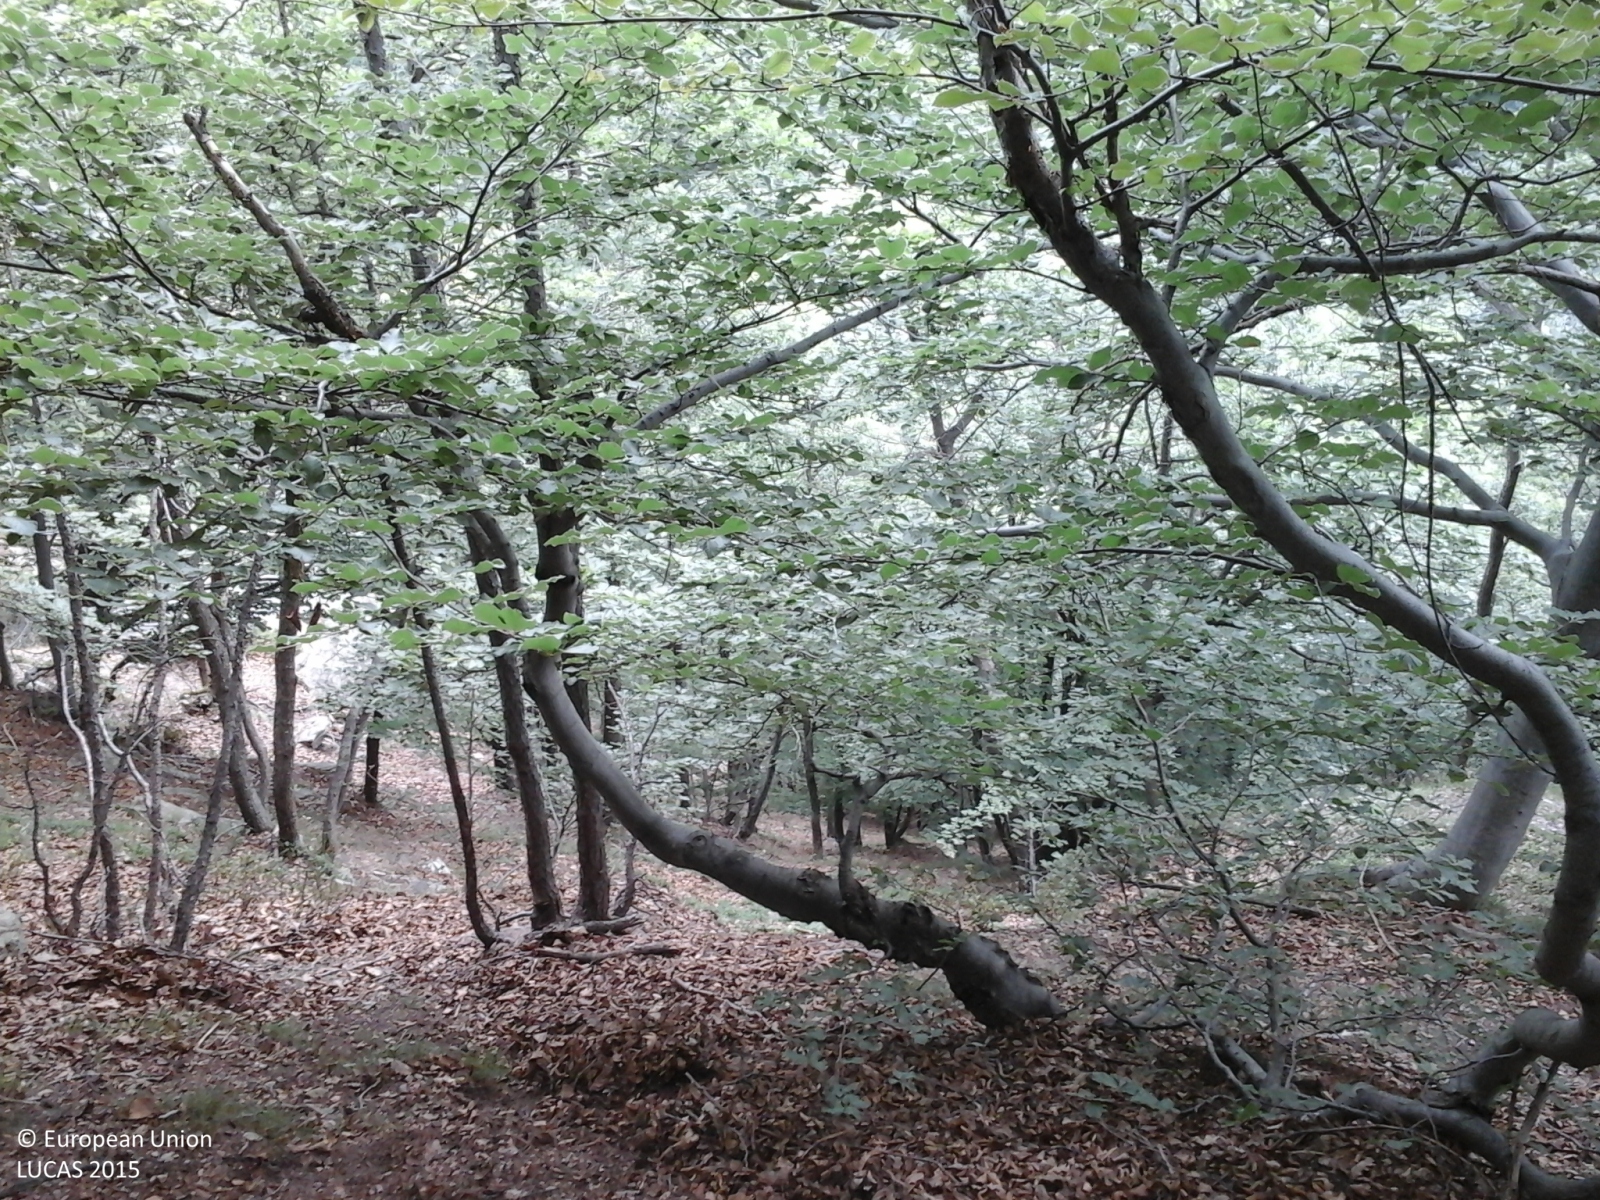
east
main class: Woodland
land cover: Broadleaved woodland
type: beech forest
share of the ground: > 75 %
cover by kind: broadleaved forest trees 100 %
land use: Semi-natural and natural areas not in use
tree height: > 5 m
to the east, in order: Broadleaved woodland; Grassland without tree/shrub cover; Dry stone walls; Broadleaved woodland; Dry stone walls; Grassland without tree/shrub cover; Tracks; Broadleaved woodland; Grassland without tree/shrub cover; Paved roads, cycling and walking lanes; Grassland without tree/shrub cover; Electric lines; Grassland without tree/shrub cover; Broadleaved woodland; Inland fresh running water
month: July
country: IT
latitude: 44.9817
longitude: 7.2528
